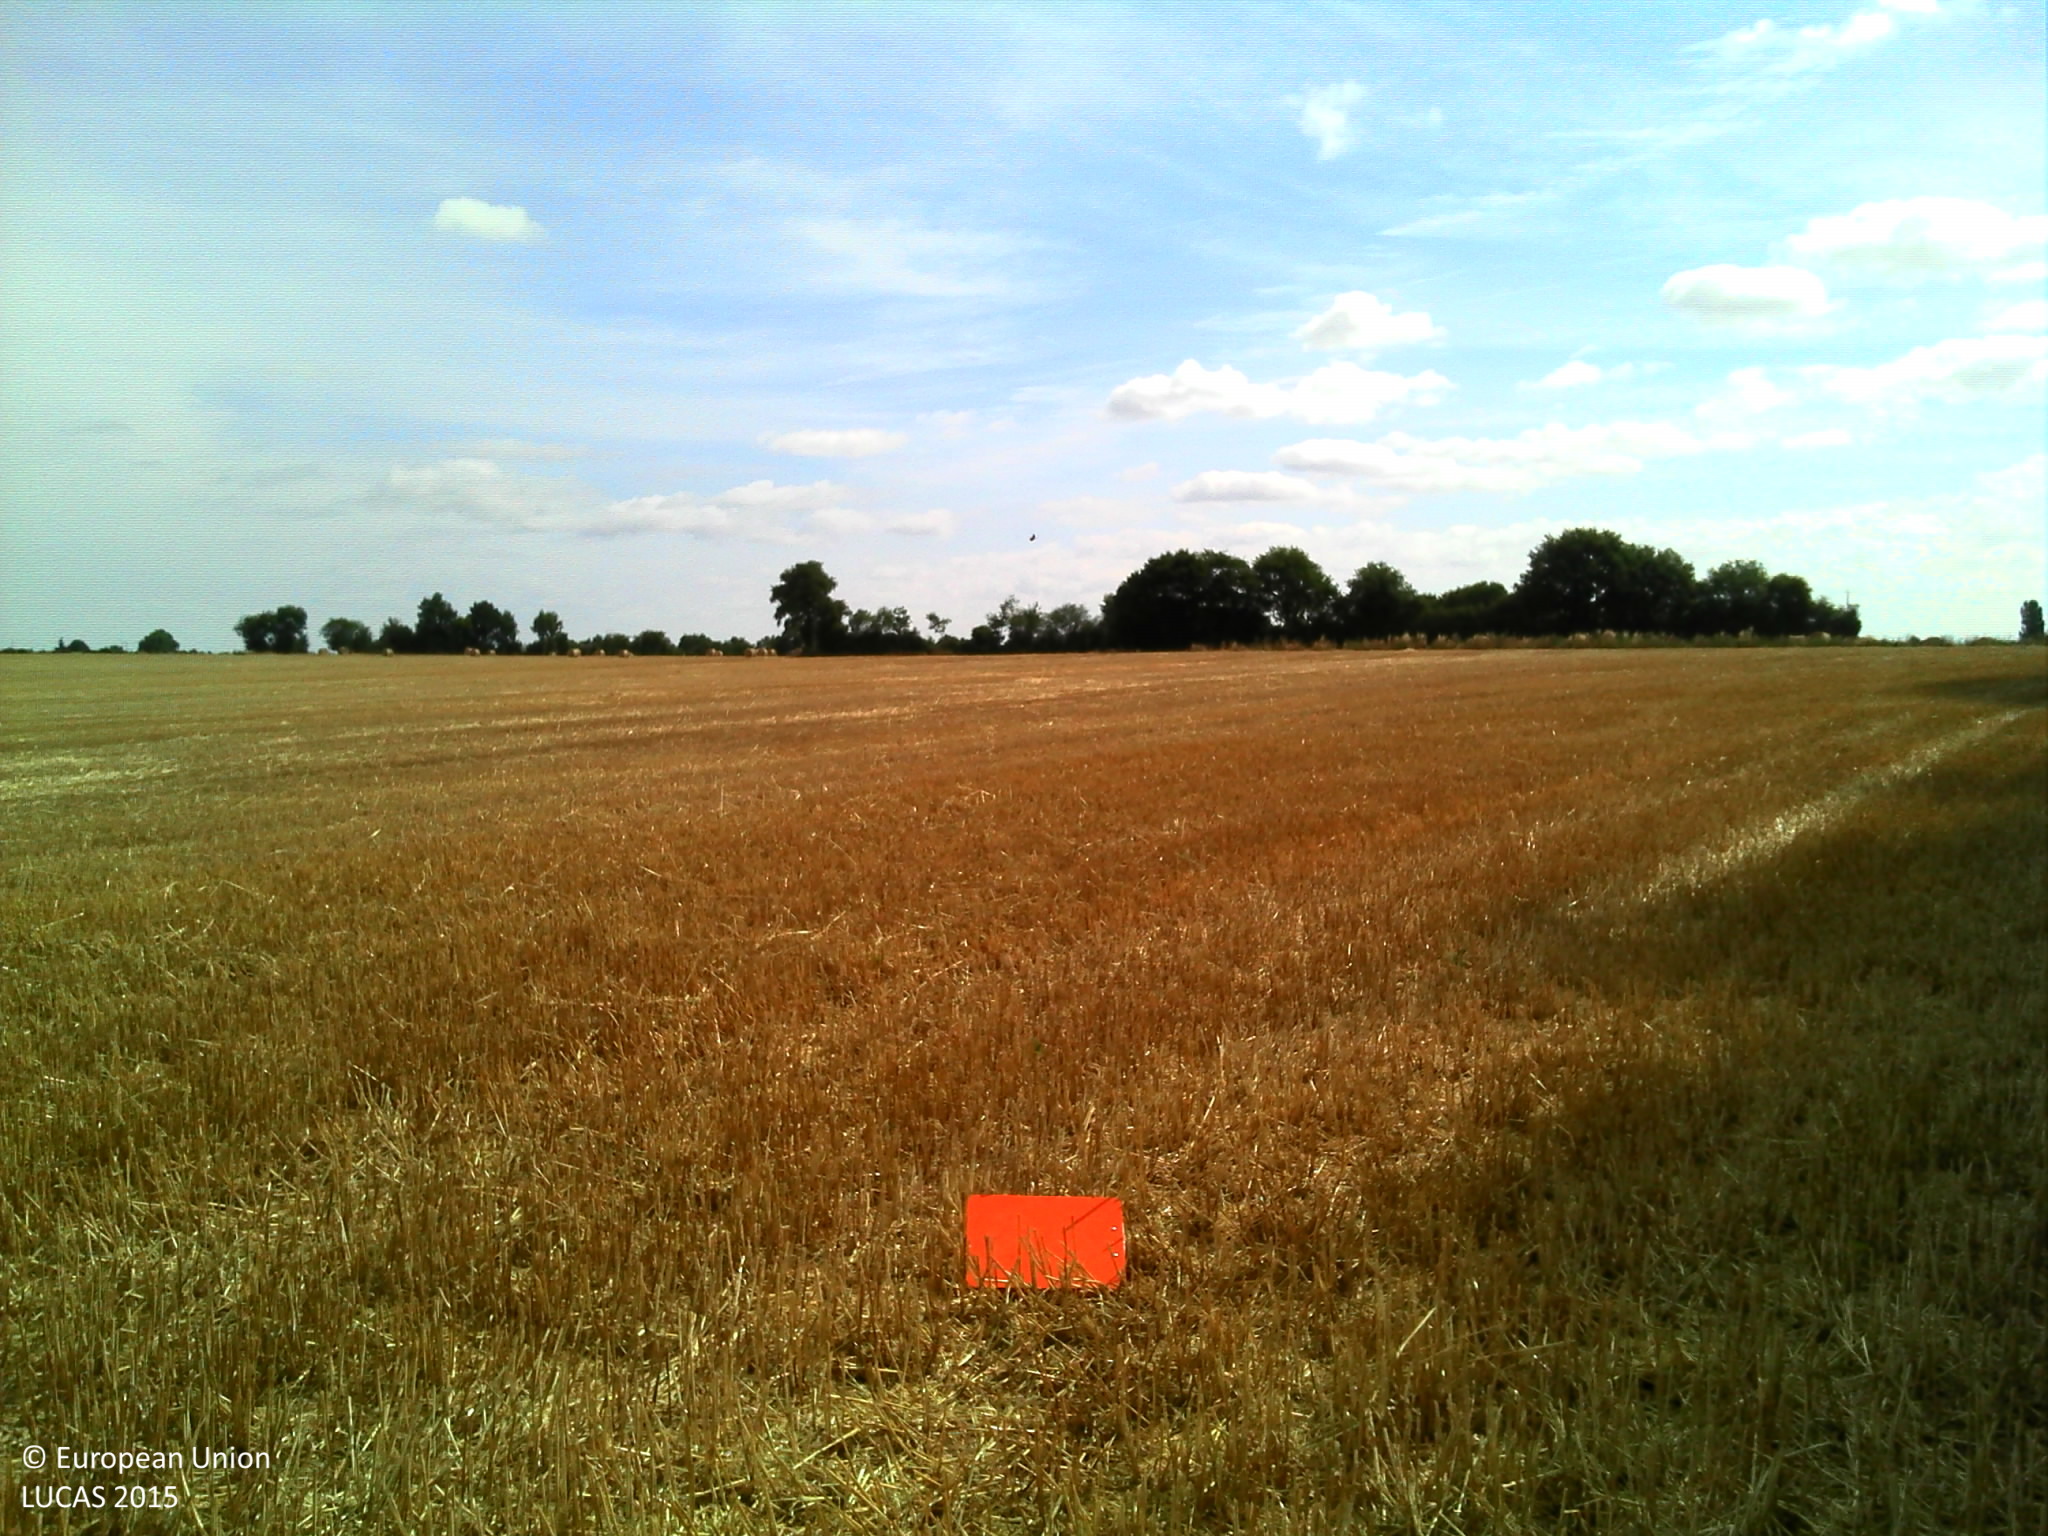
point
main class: Cropland
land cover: Common wheat
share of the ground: > 75 %
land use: Agriculture (excluding fallow land and kitchen gardens)
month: July
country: FR
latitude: 47.8603
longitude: 0.6351
